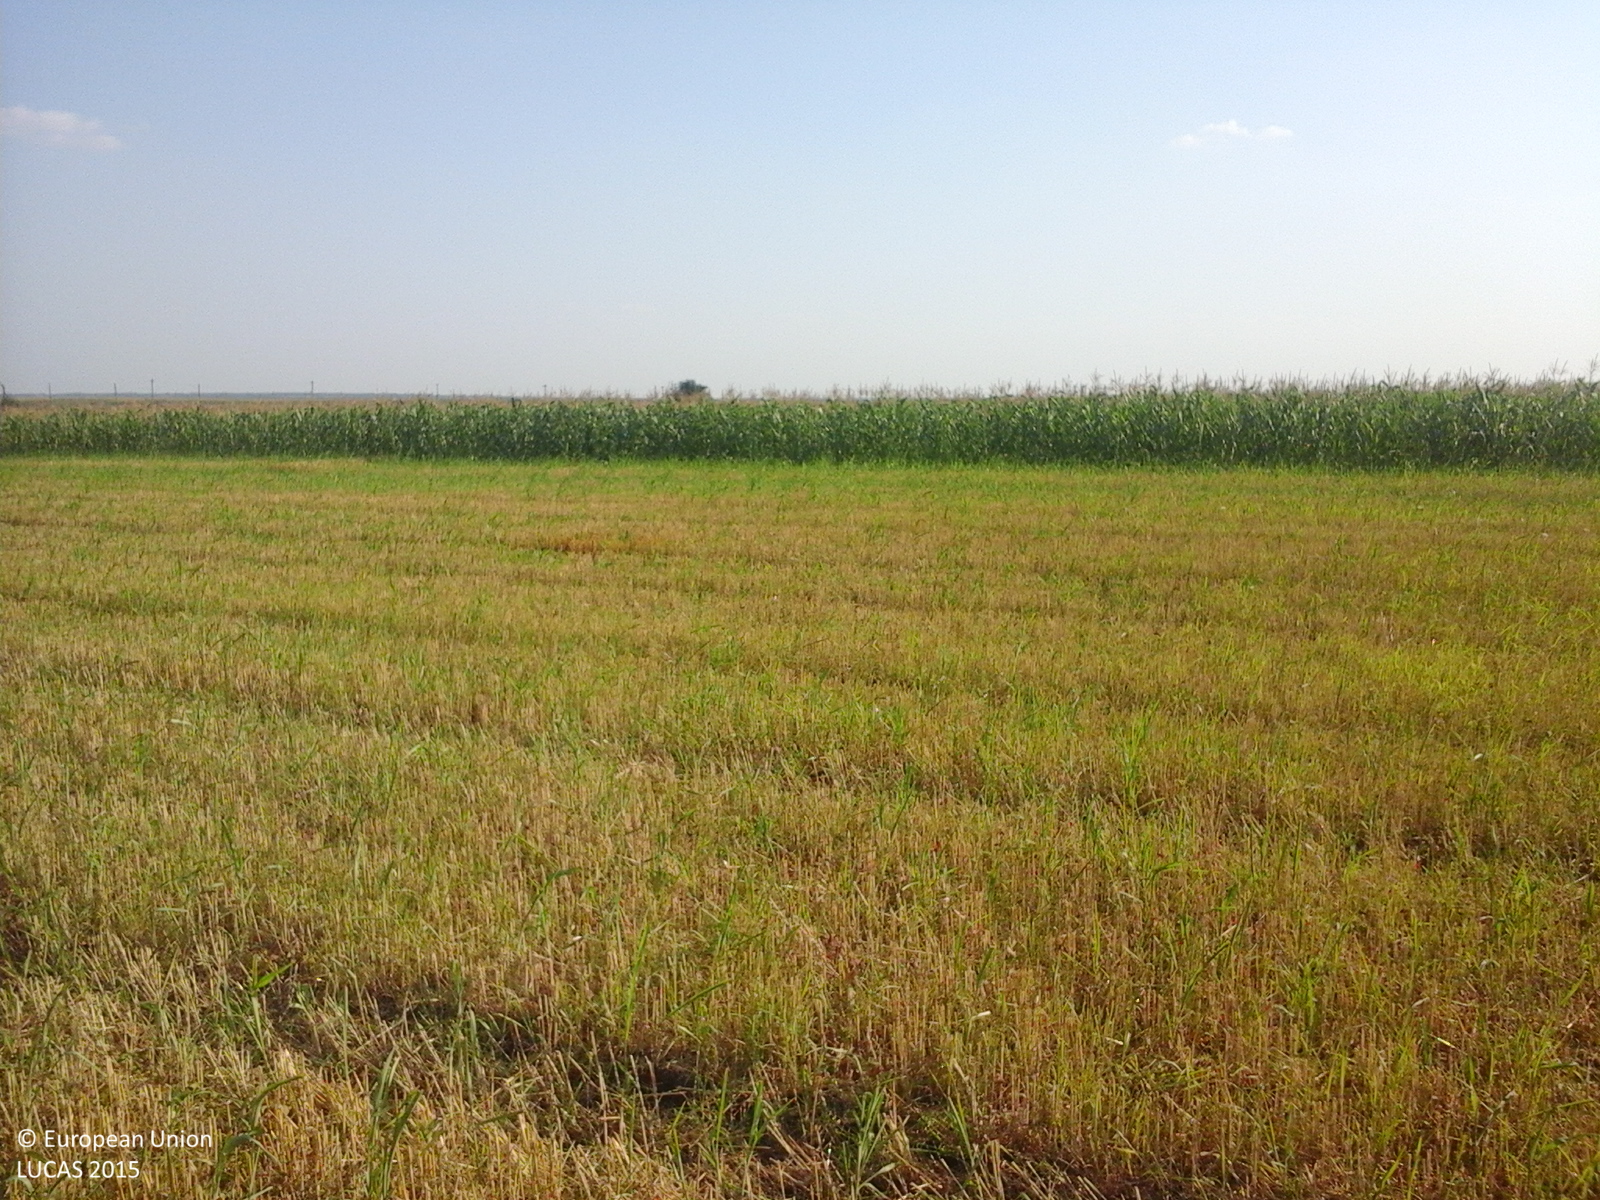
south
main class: Cropland
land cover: Common wheat
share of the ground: 25 - 50 %
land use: Agriculture (excluding fallow land and kitchen gardens)
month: July
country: RO
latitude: 44.9215
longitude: 26.5525
